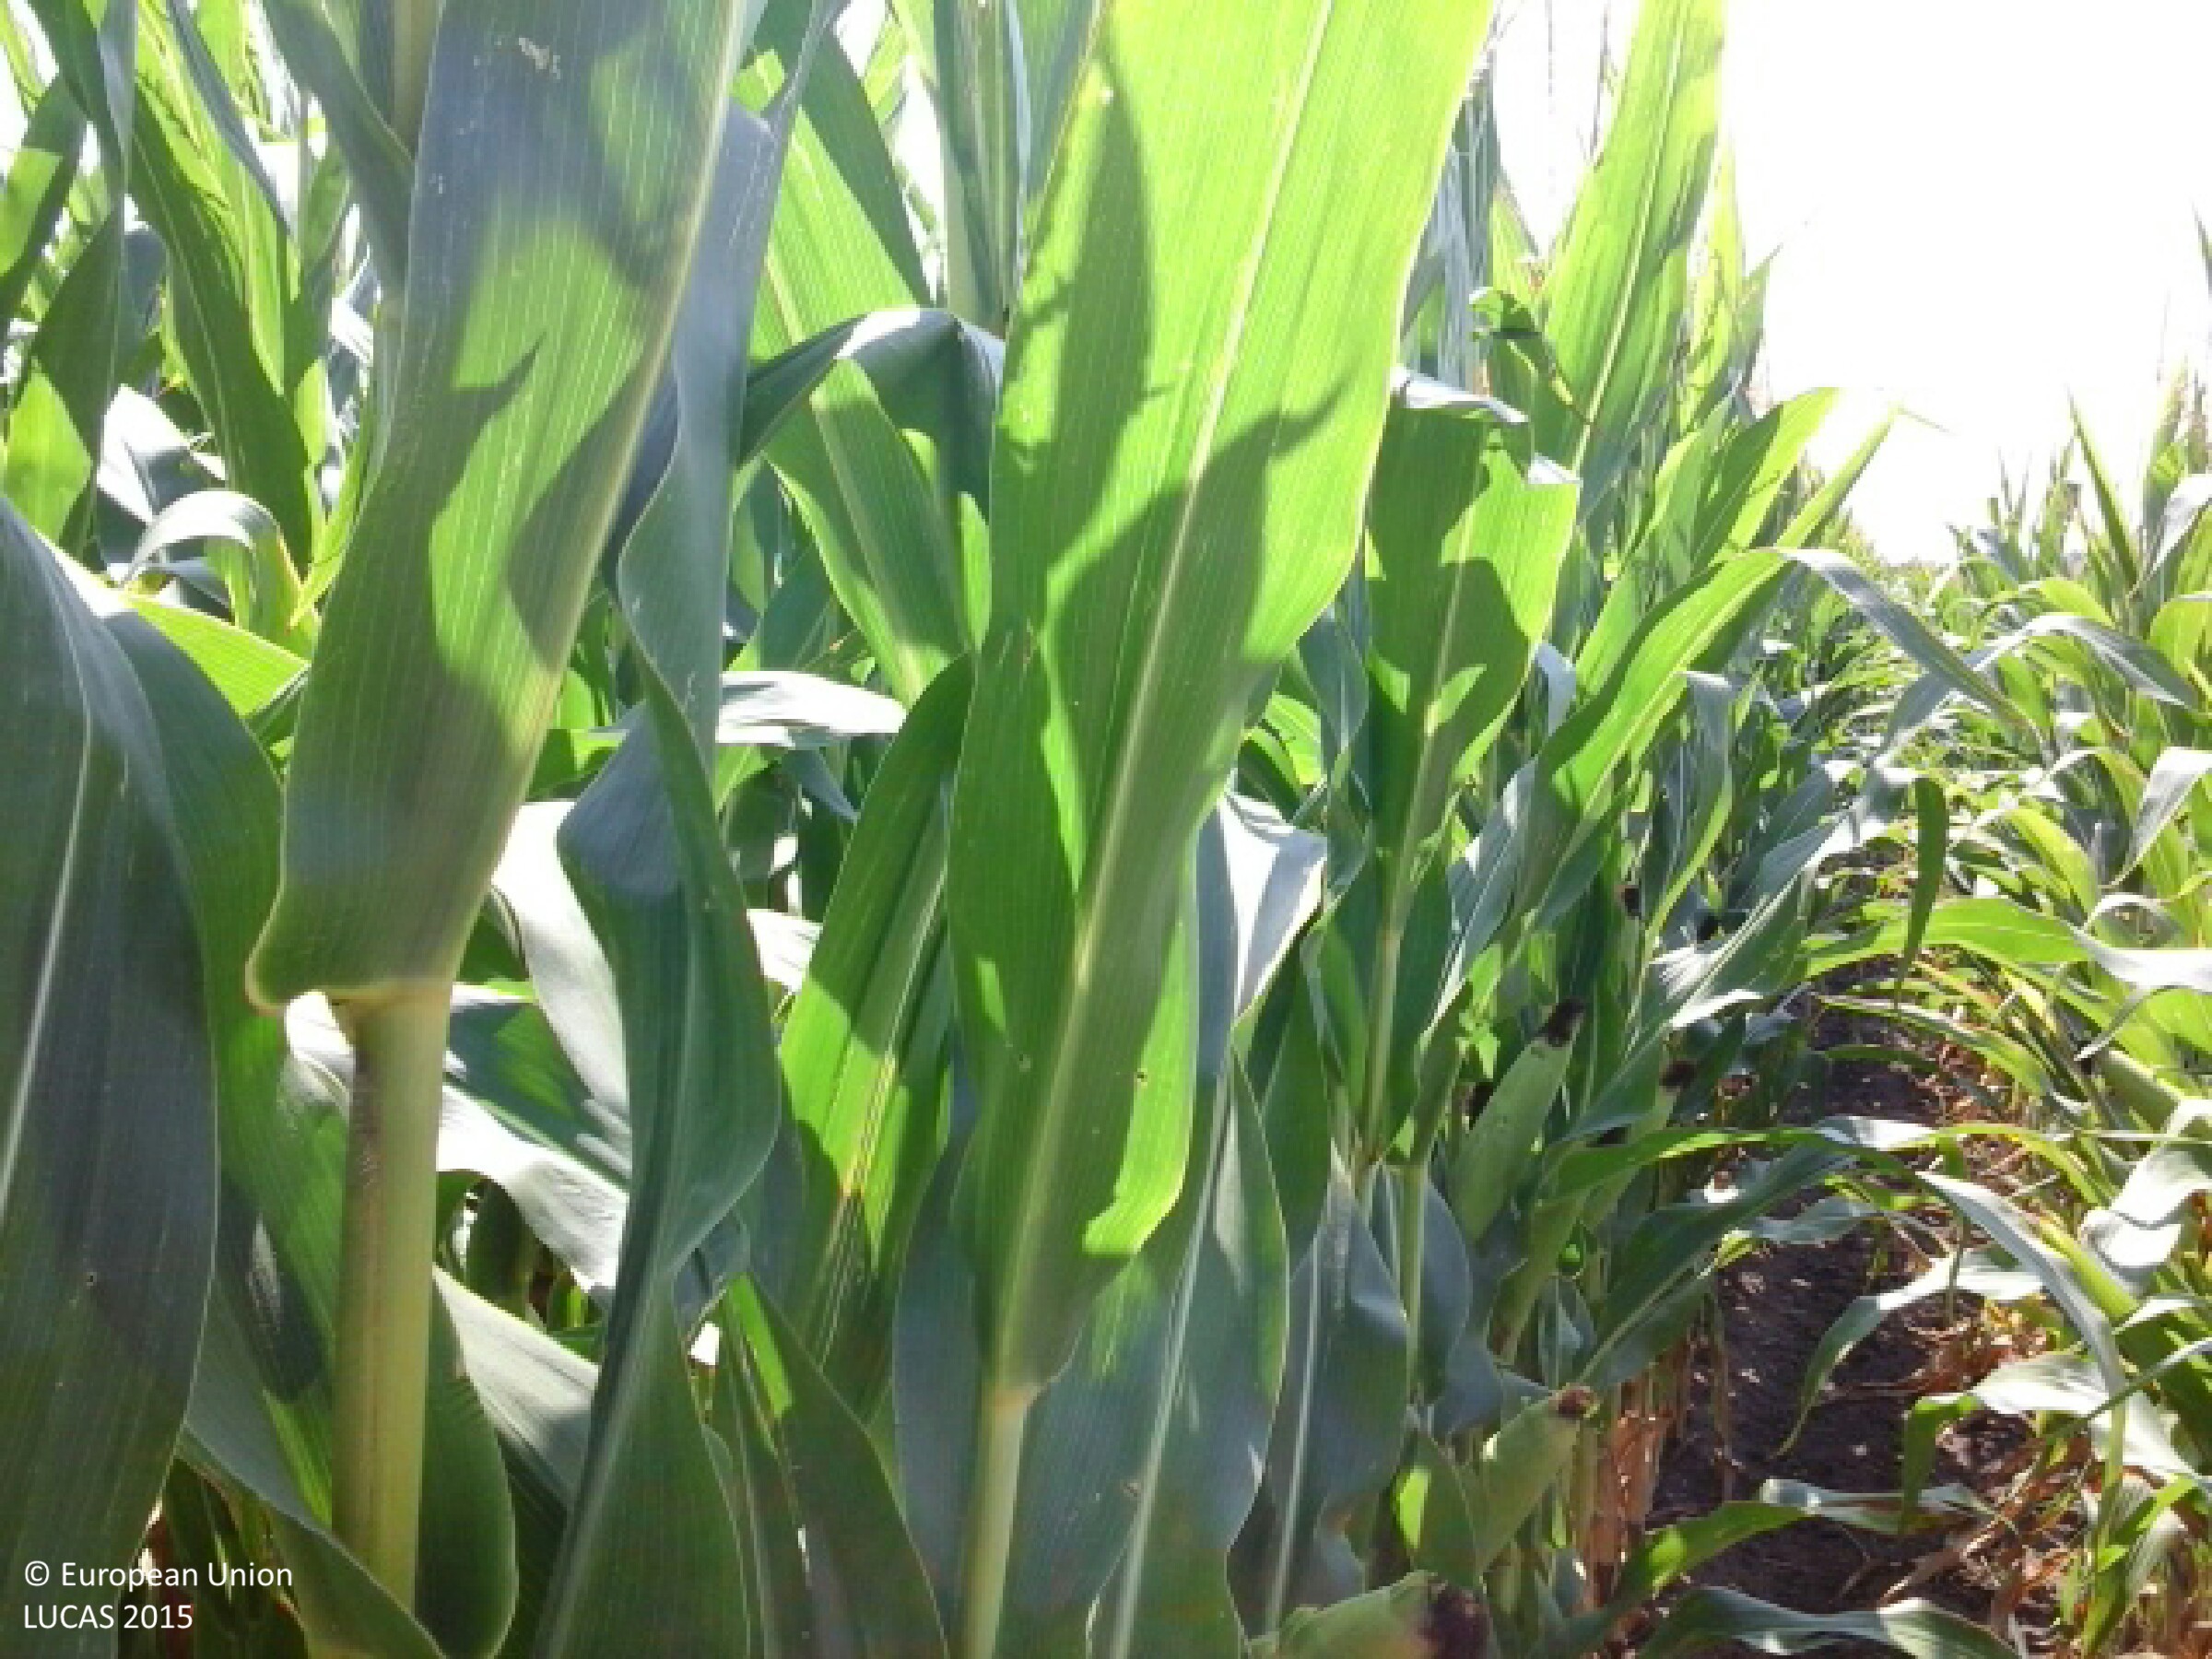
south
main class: Cropland
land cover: Maize
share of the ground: > 75 %
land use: Agriculture (excluding fallow land and kitchen gardens)
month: August
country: HU
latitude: 47.5948
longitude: 18.1644
